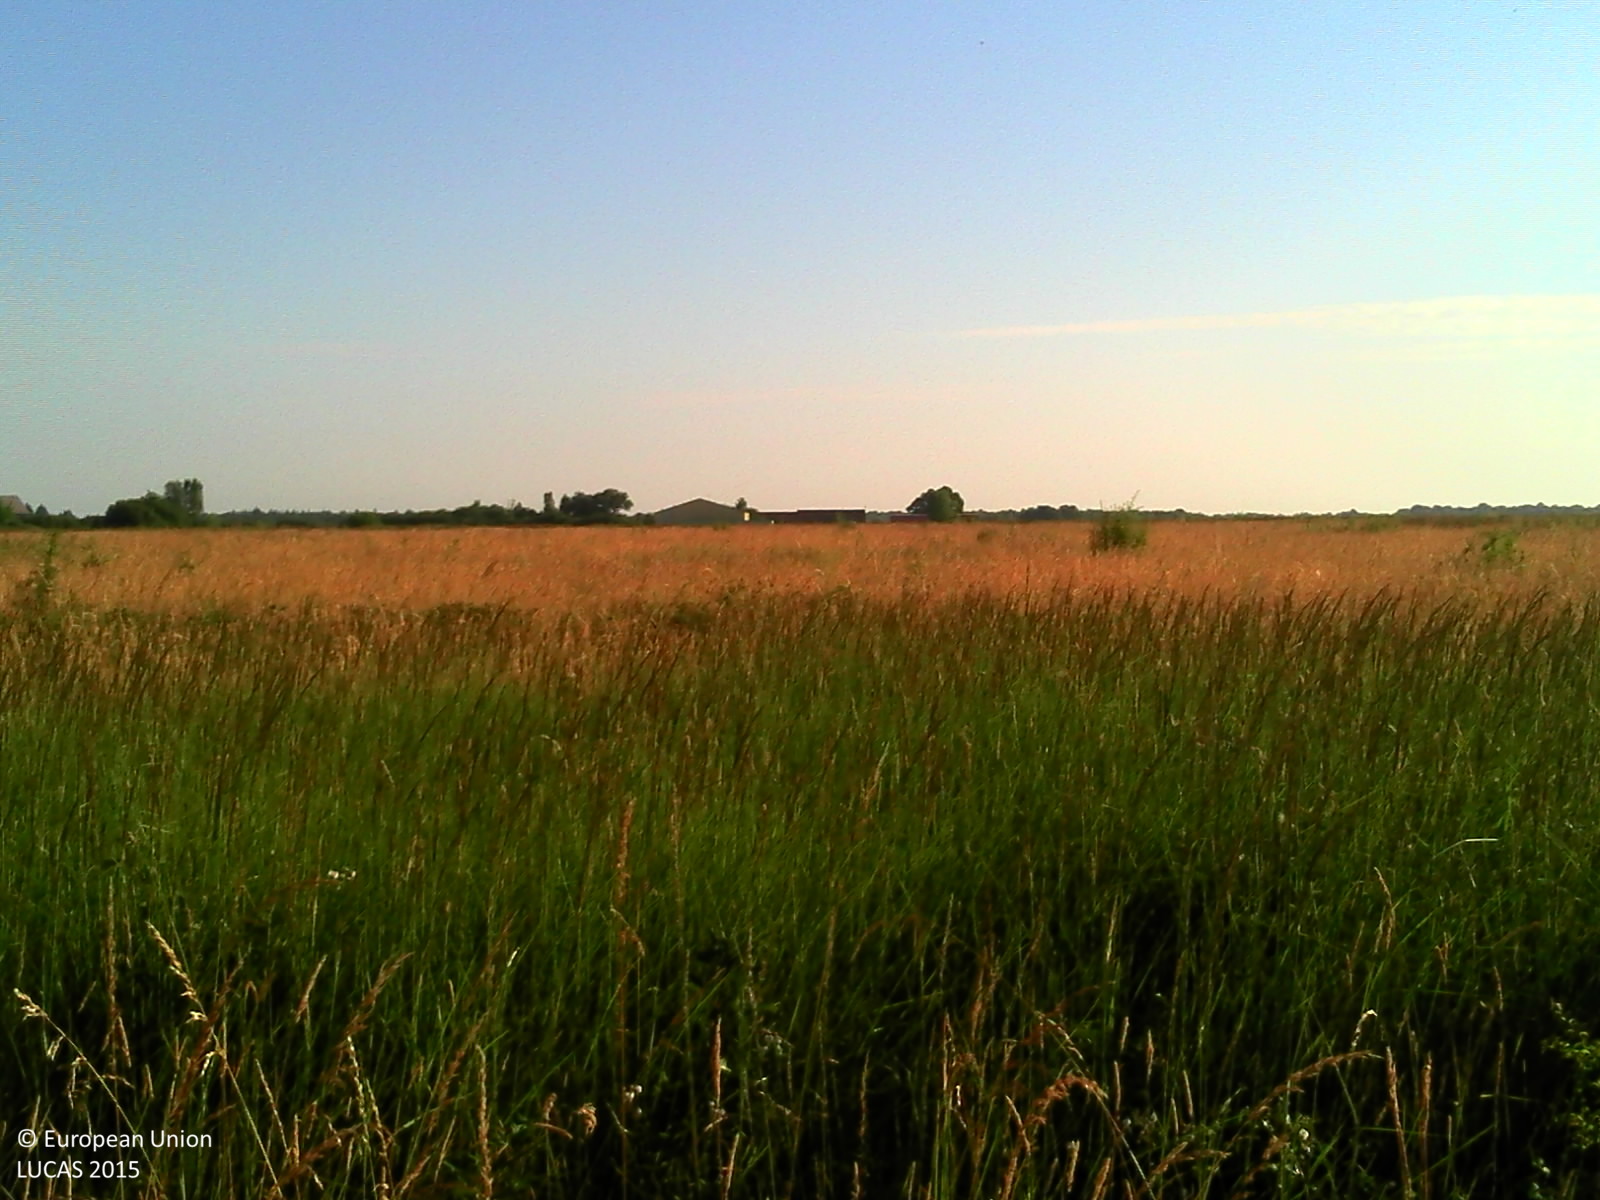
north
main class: Grassland
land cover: Grassland without tree/shrub cover
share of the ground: > 75 %
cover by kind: herbaceous plants 100 %
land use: Agriculture (excluding fallow land and kitchen gardens)
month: June
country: FR
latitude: 47.7714
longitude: 2.0222
